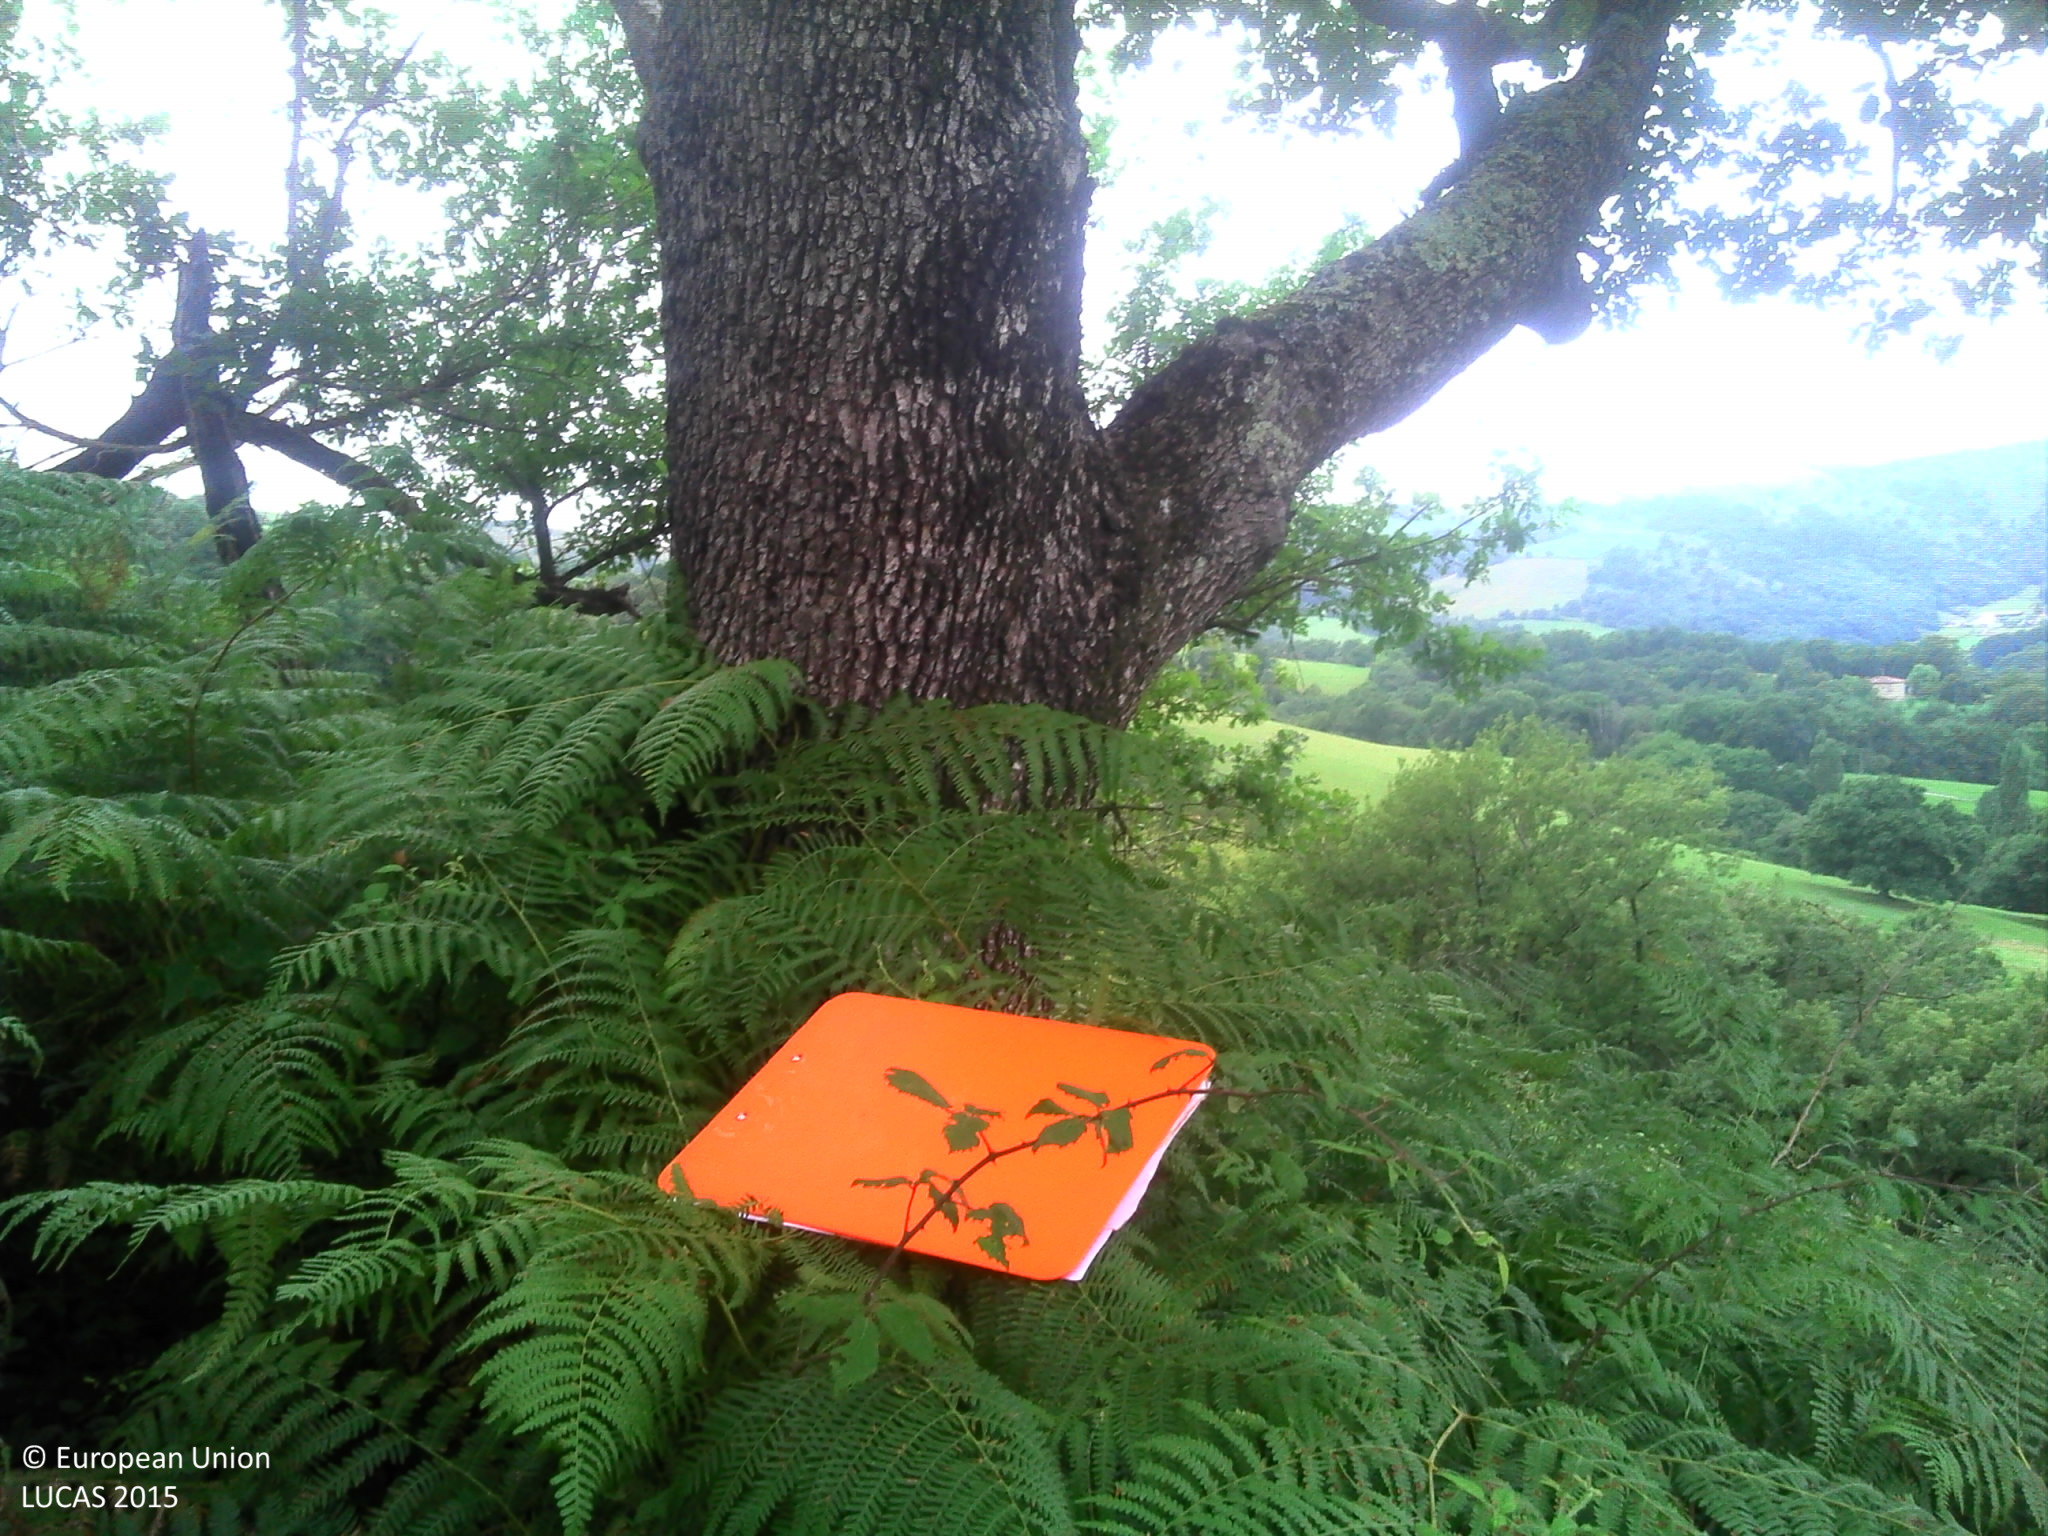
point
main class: Woodland
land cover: Broadleaved woodland
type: thermophilous deciduous forest
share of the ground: > 75 %
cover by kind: broadleaved forest trees 95 %, shrubs 5 %
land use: Forestry
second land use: Agriculture (excluding fallow land and kitchen gardens)
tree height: > 5 m
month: August
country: FR
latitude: 43.2400
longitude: -1.1332
